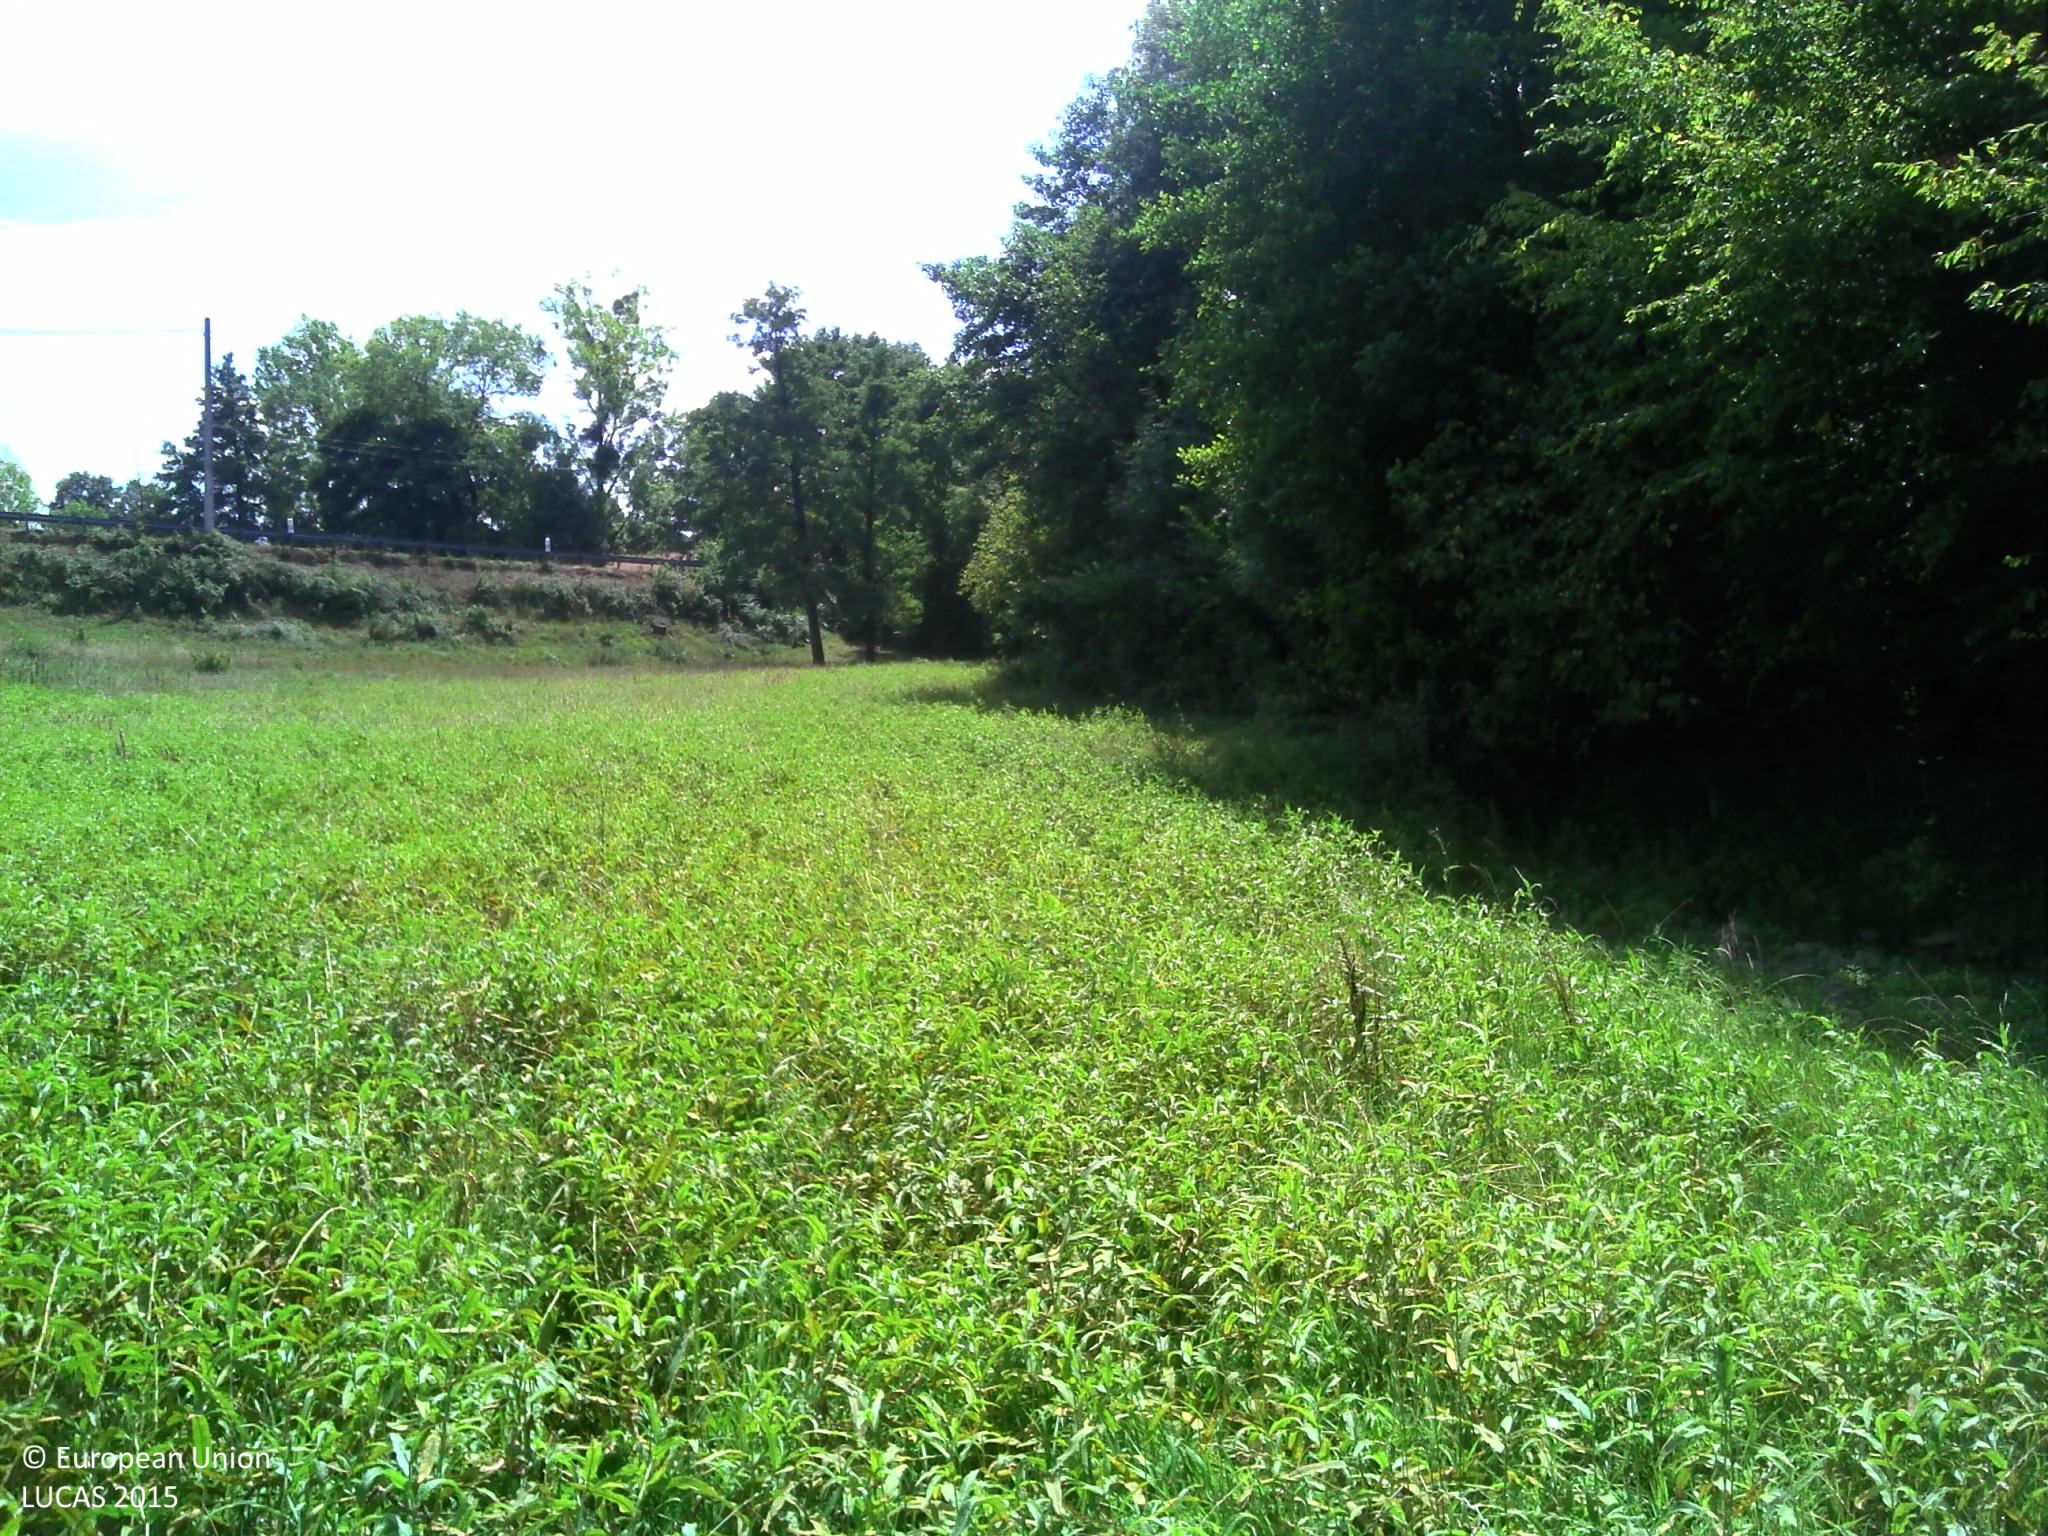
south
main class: Grassland
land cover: Grassland without tree/shrub cover
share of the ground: > 75 %
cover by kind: herbaceous plants 100 %
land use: Agriculture (excluding fallow land and kitchen gardens)
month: August
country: FR
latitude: 46.7834
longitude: -1.1556
